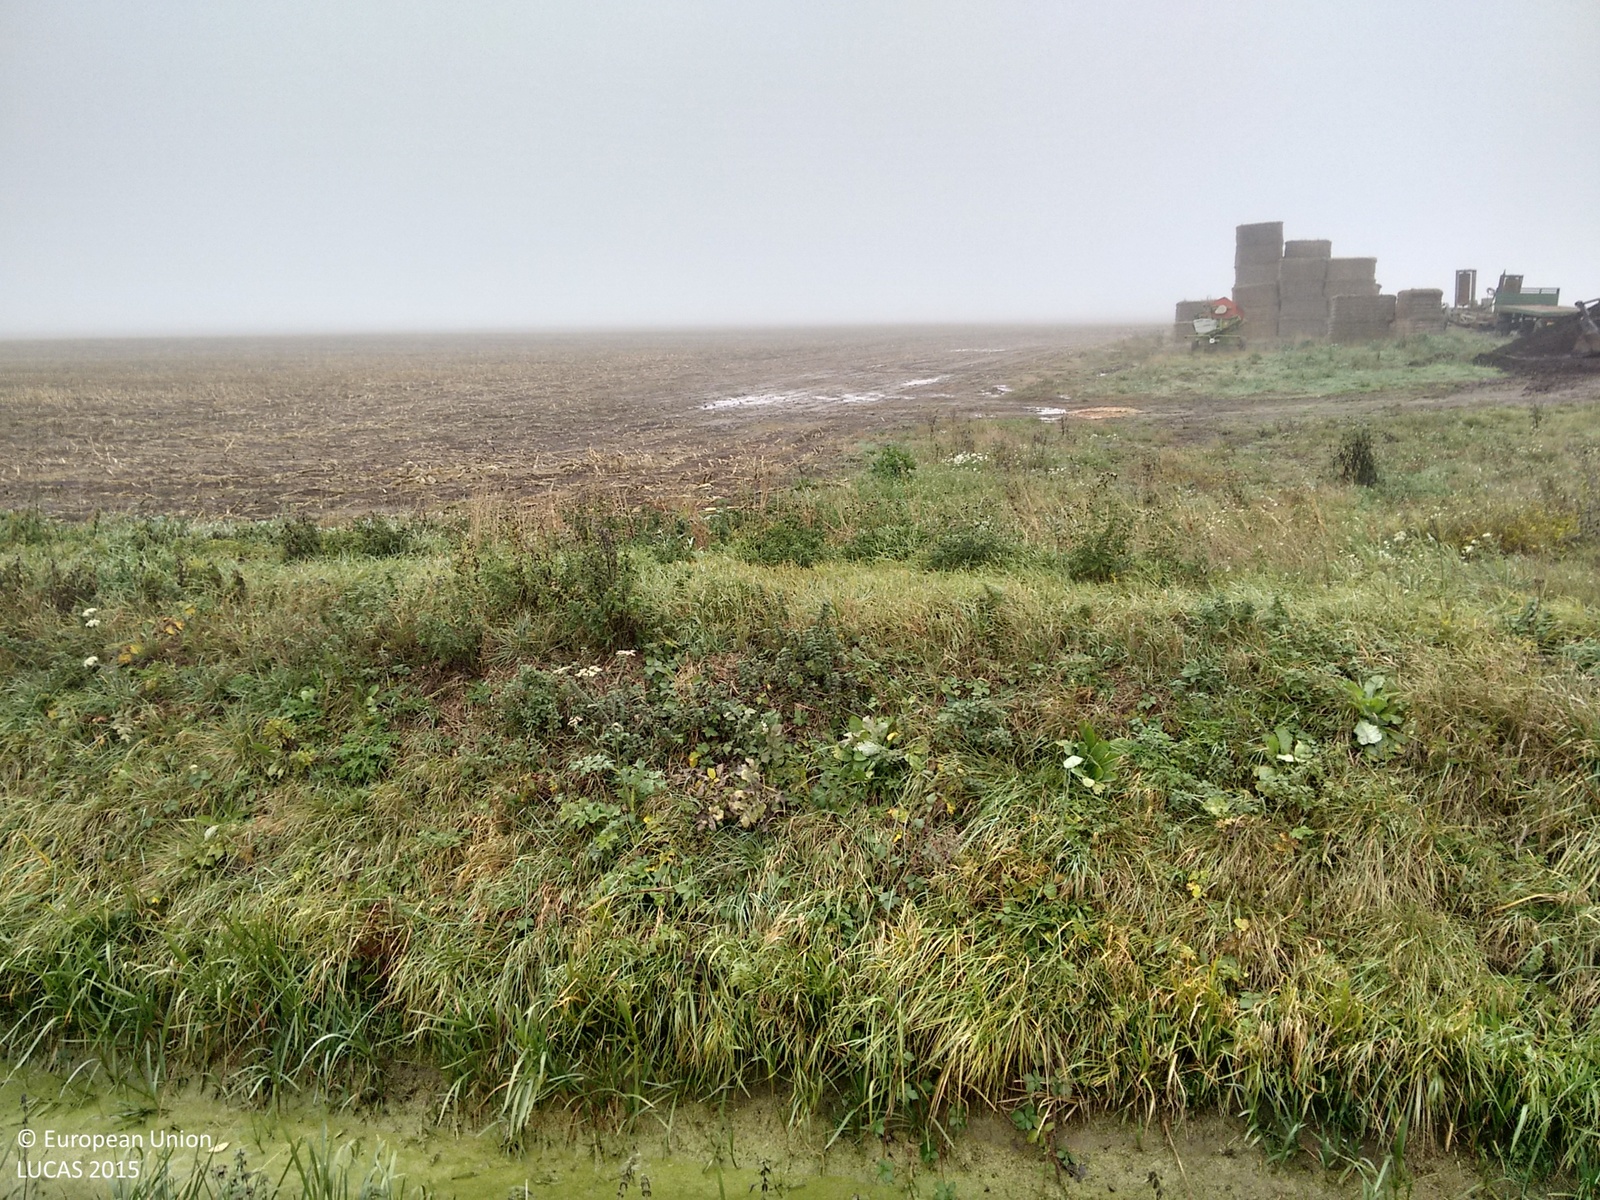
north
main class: Cropland
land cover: Maize
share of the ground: > 75 %
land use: Agriculture (excluding fallow land and kitchen gardens)
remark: Harvested field
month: November
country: GB
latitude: 53.0939
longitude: -0.0225
